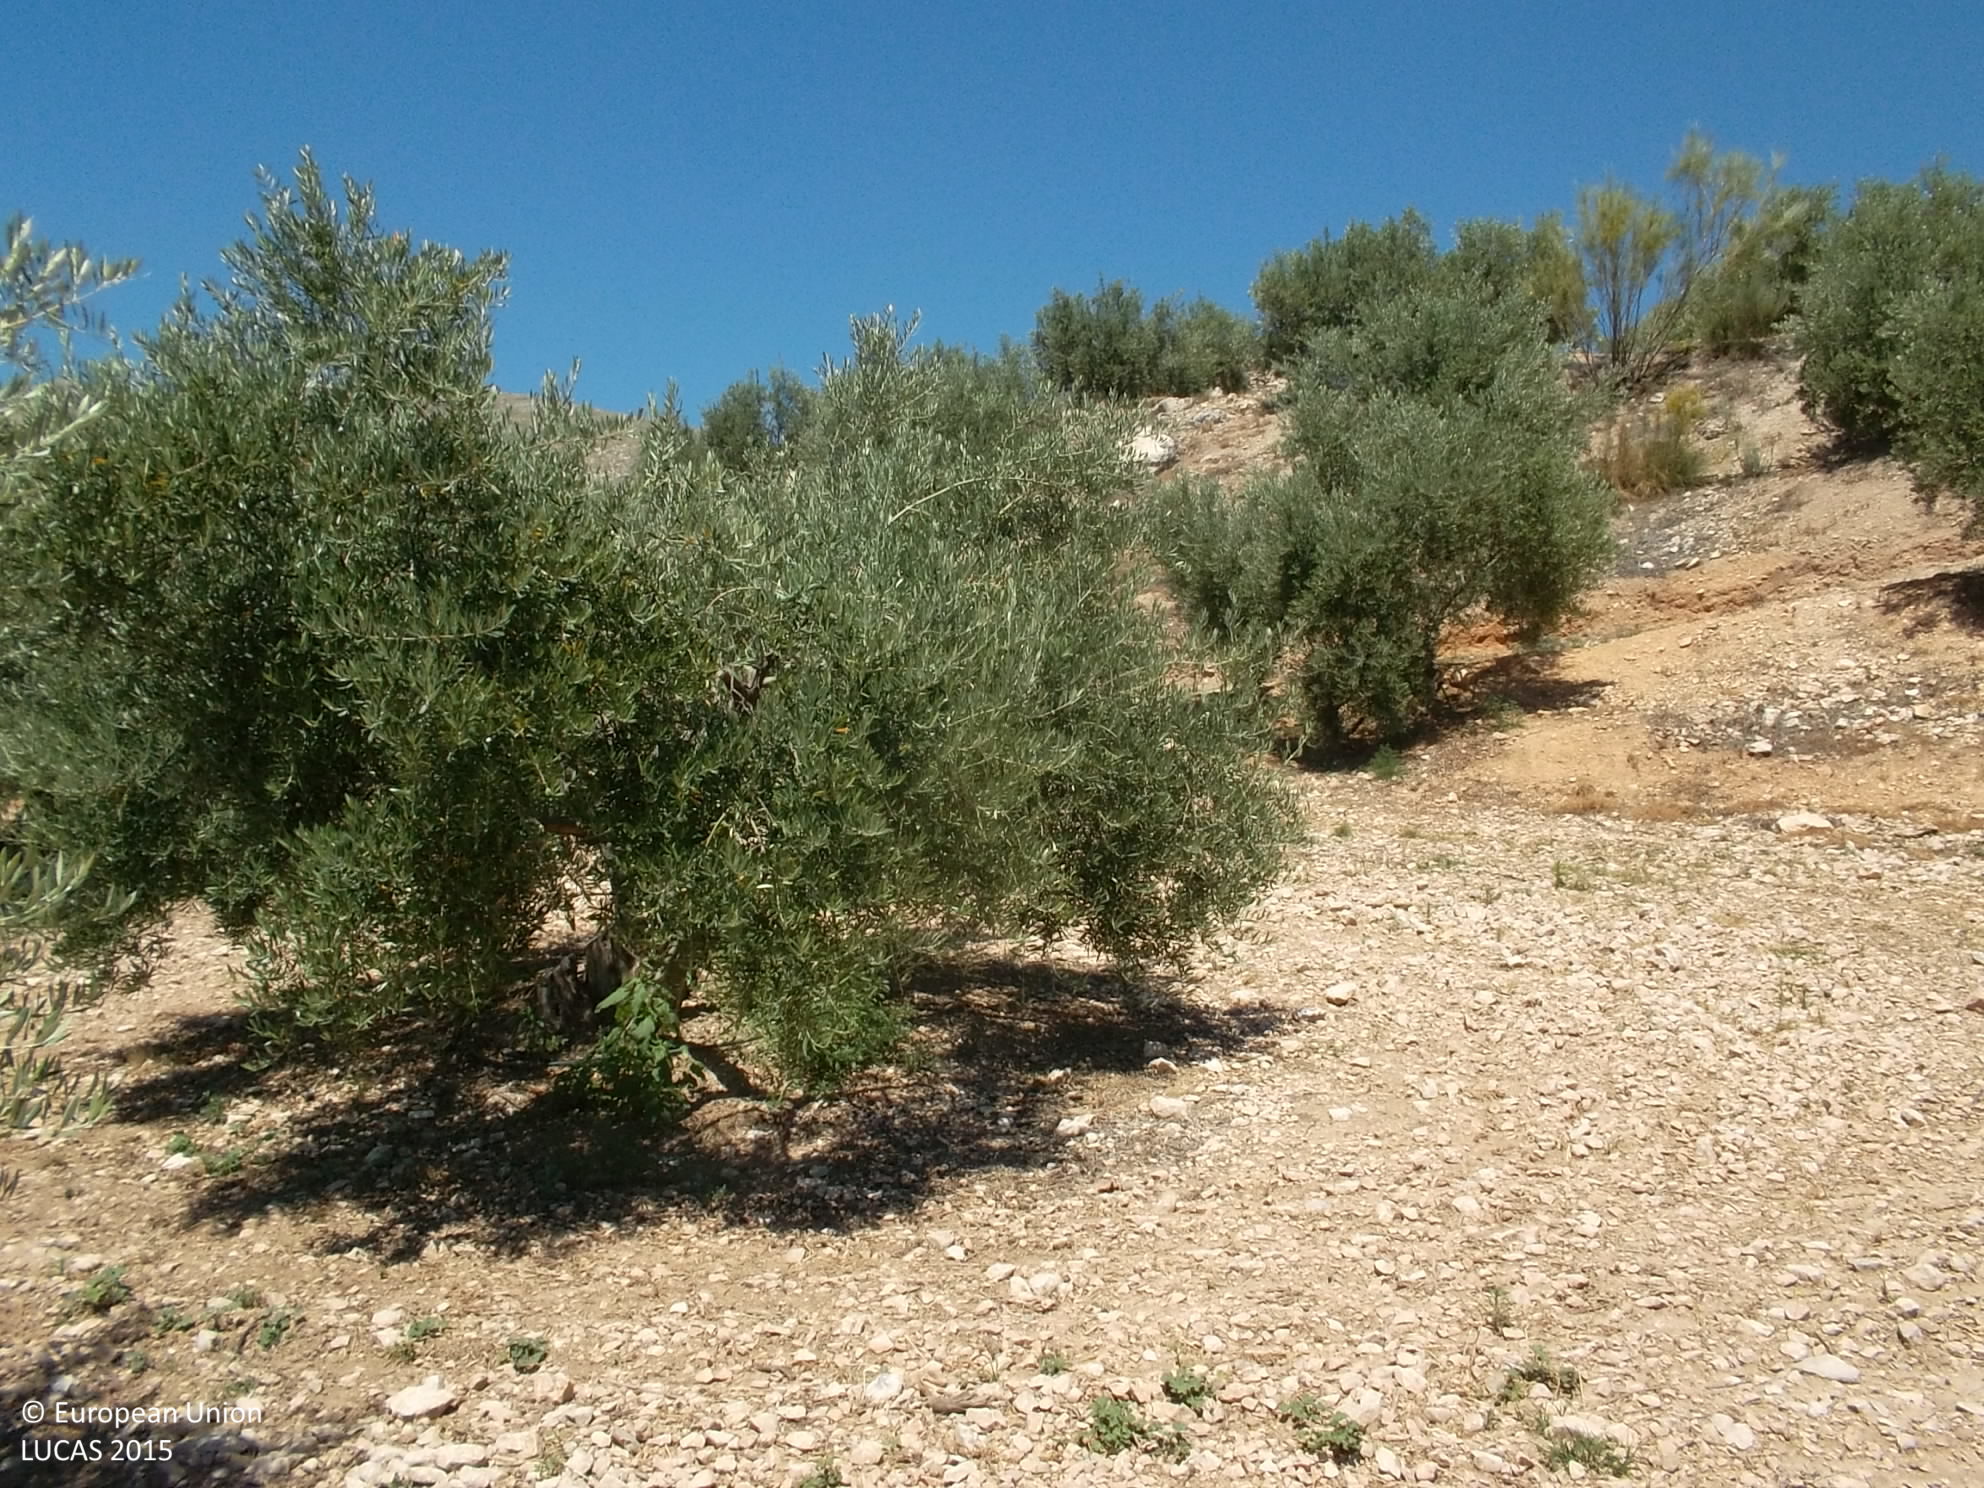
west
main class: Cropland
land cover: Olive groves
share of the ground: 25 - 50 %
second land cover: Grassland without tree/shrub cover
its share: 10 - 25 %
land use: Agriculture (excluding fallow land and kitchen gardens)
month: June
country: ES
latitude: 37.8265
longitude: -3.3694
